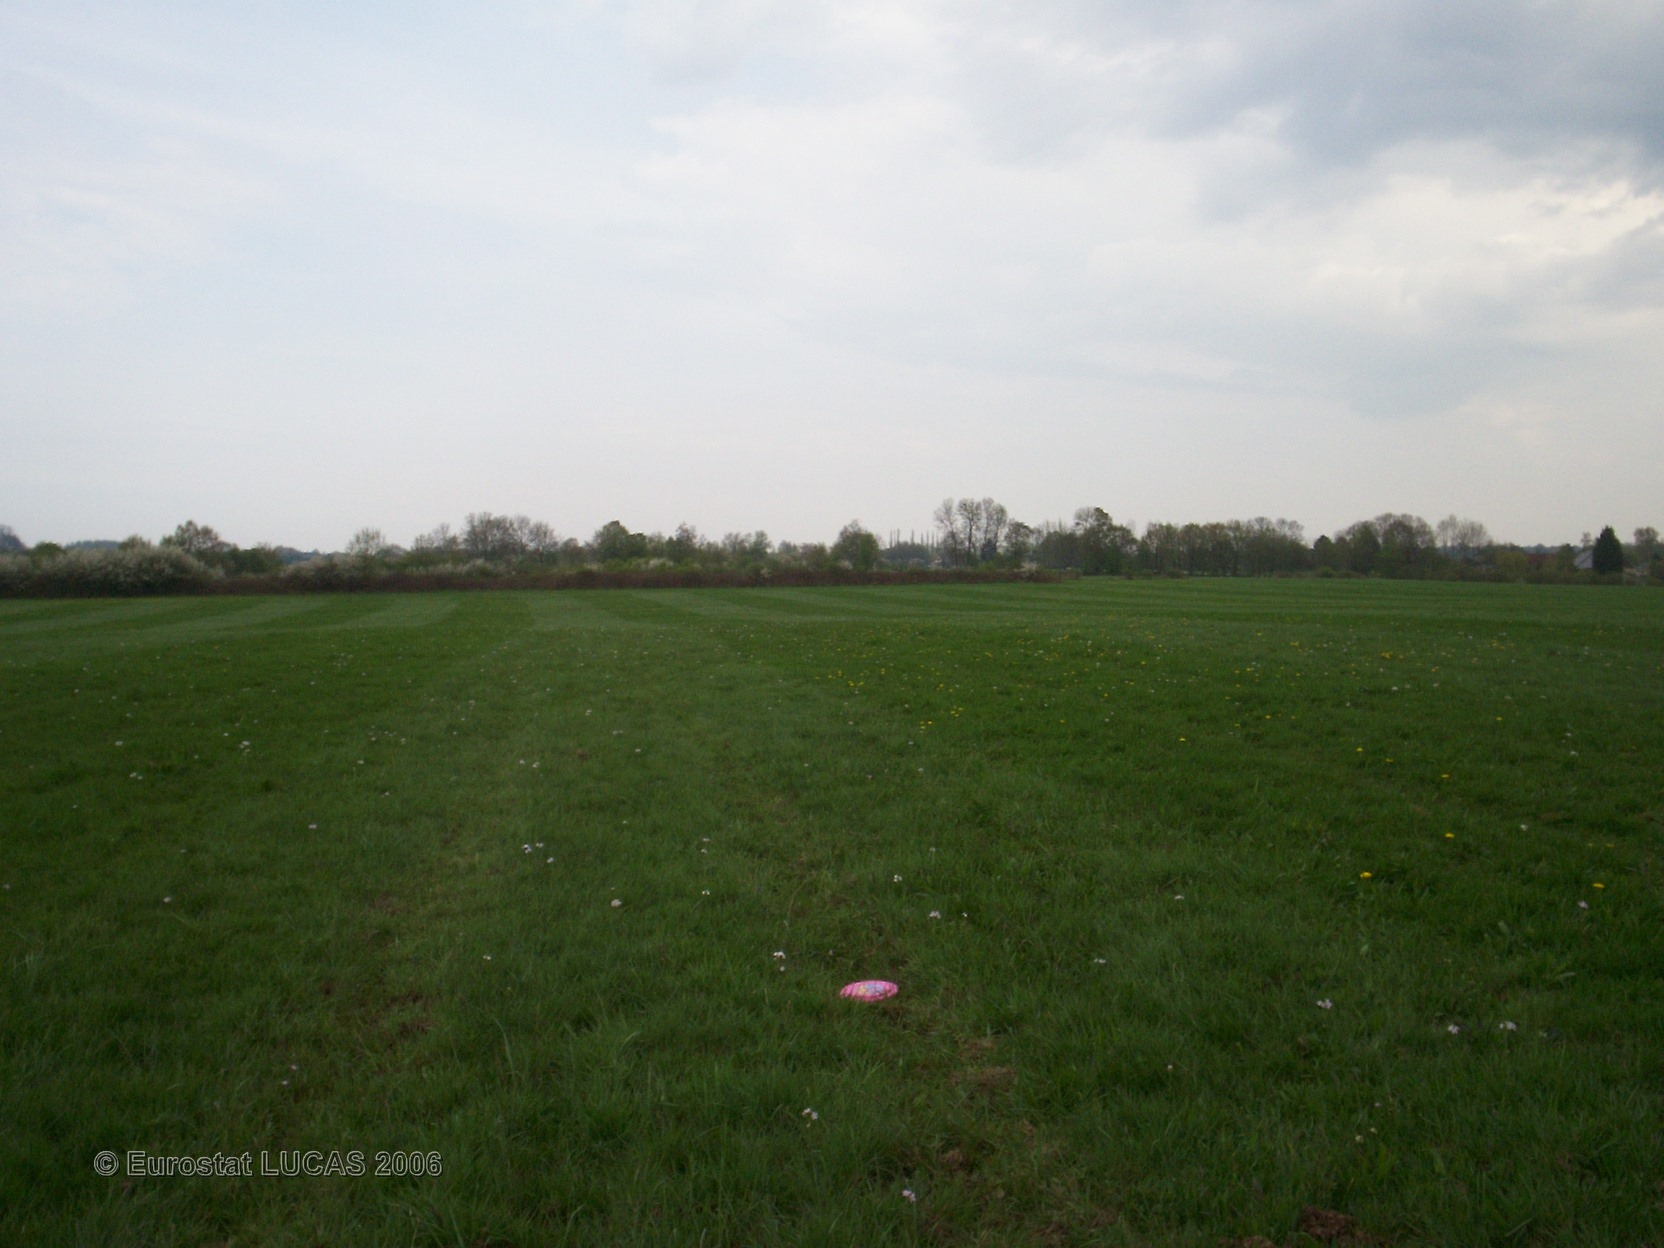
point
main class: Grassland
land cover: Grassland without tree/shrub cover
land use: Agriculture (excluding fallow land and kitchen gardens)
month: May
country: FR
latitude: 49.8961
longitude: 4.2738
